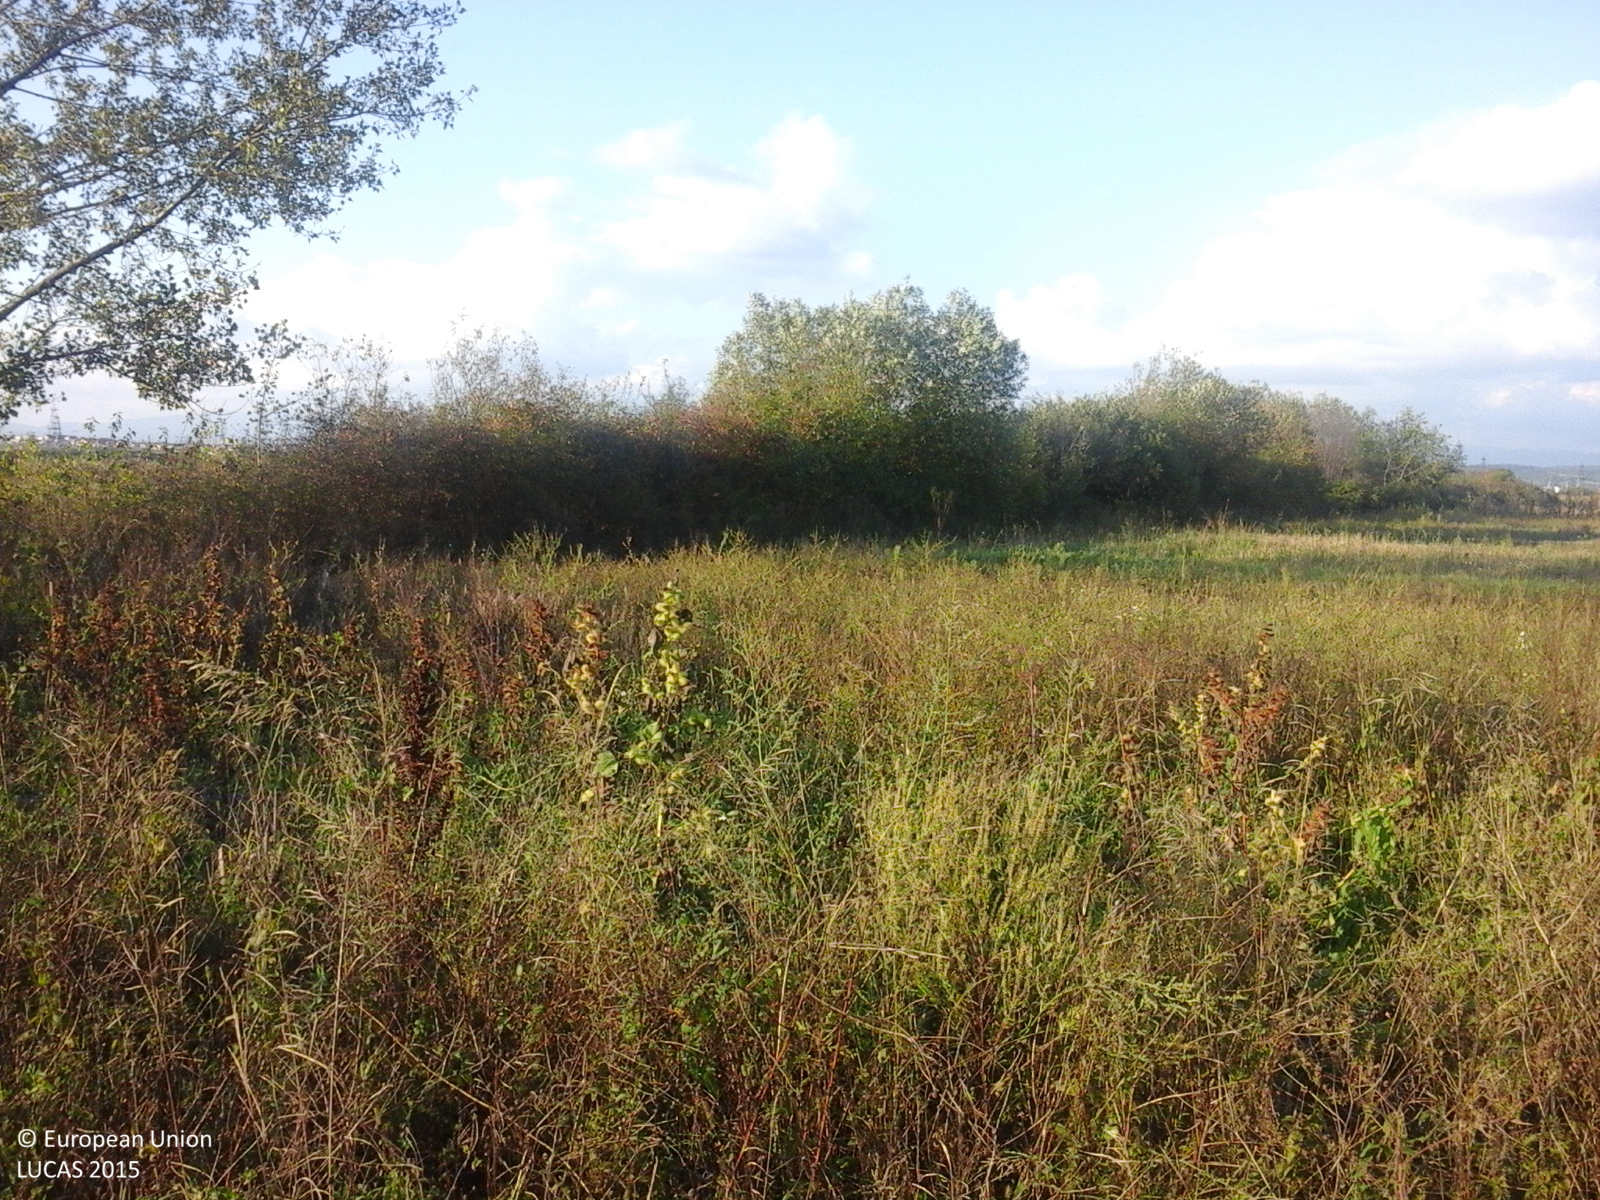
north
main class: Grassland
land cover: Spontaneously vegetated surfaces
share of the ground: > 75 %
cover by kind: herbaceous plants 100 %
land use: Fallow land
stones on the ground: < 10 %
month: September
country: RO
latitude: 45.0069
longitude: 23.5706
